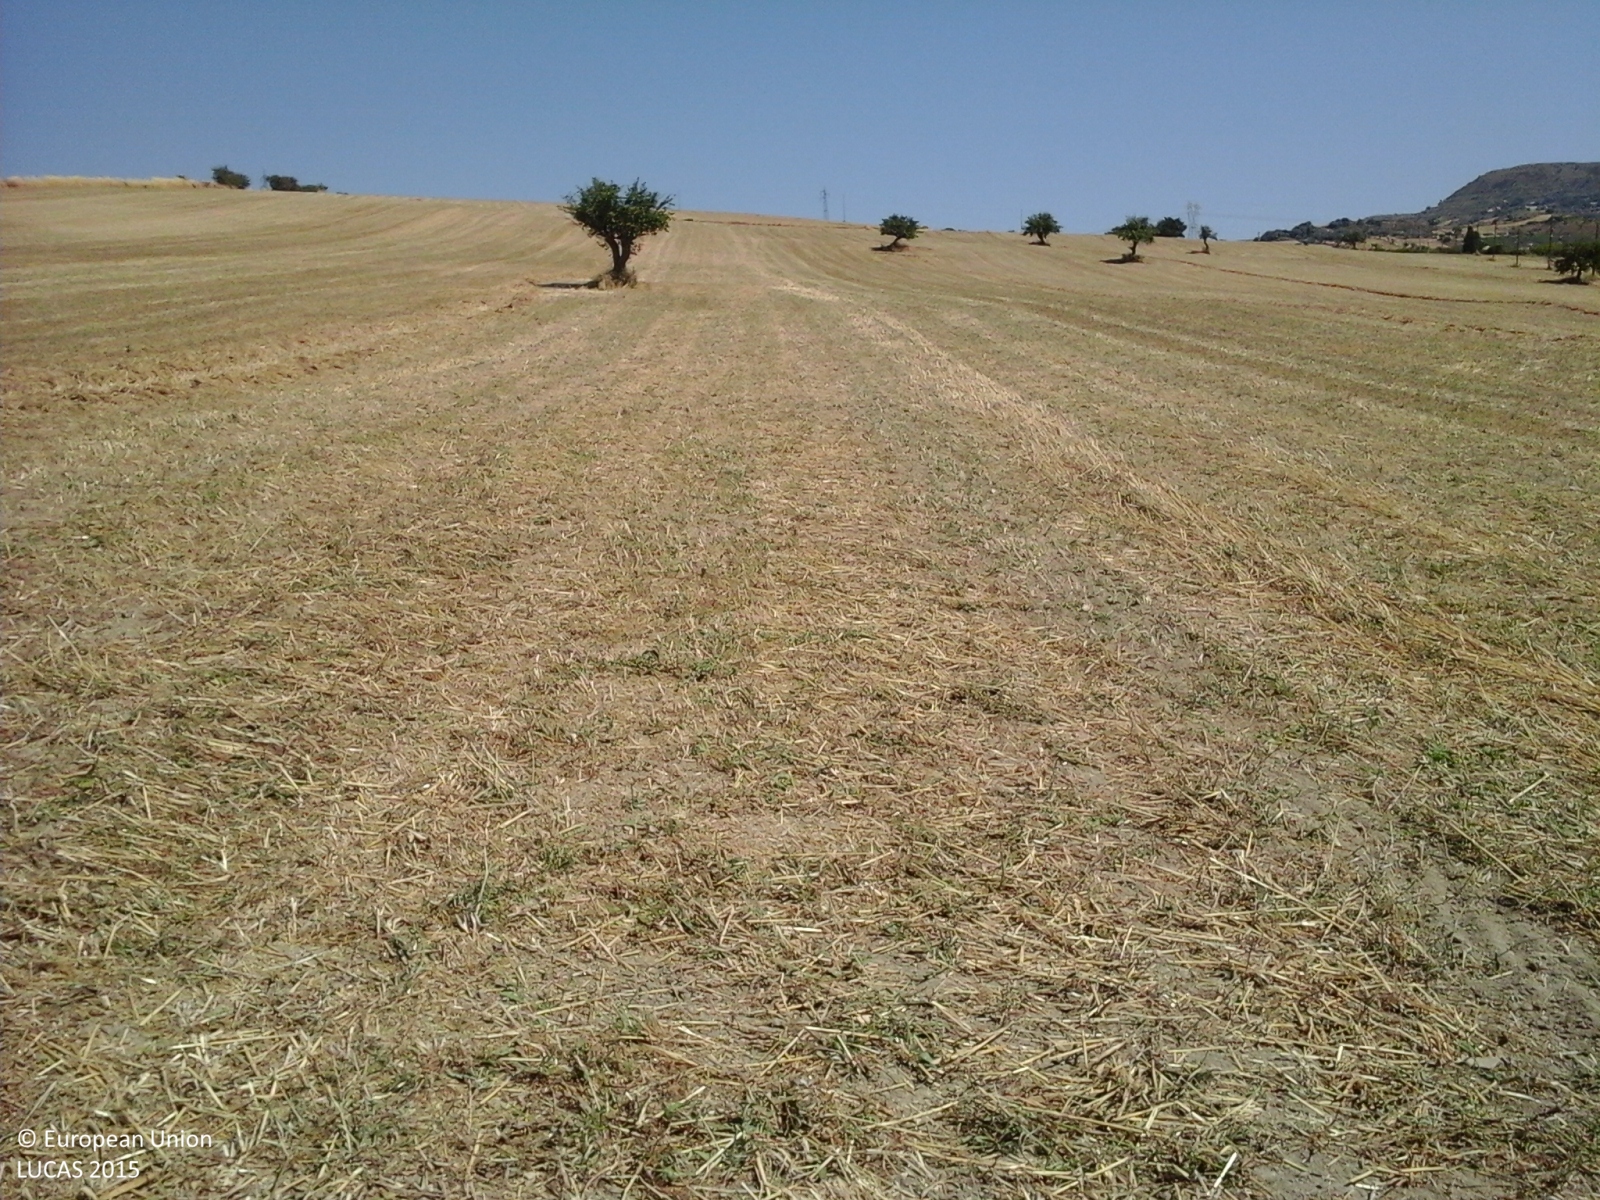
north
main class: Cropland
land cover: Durum wheat
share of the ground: > 75 %
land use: Agriculture (excluding fallow land and kitchen gardens)
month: July
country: IT
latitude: 37.0223
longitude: 14.8741
